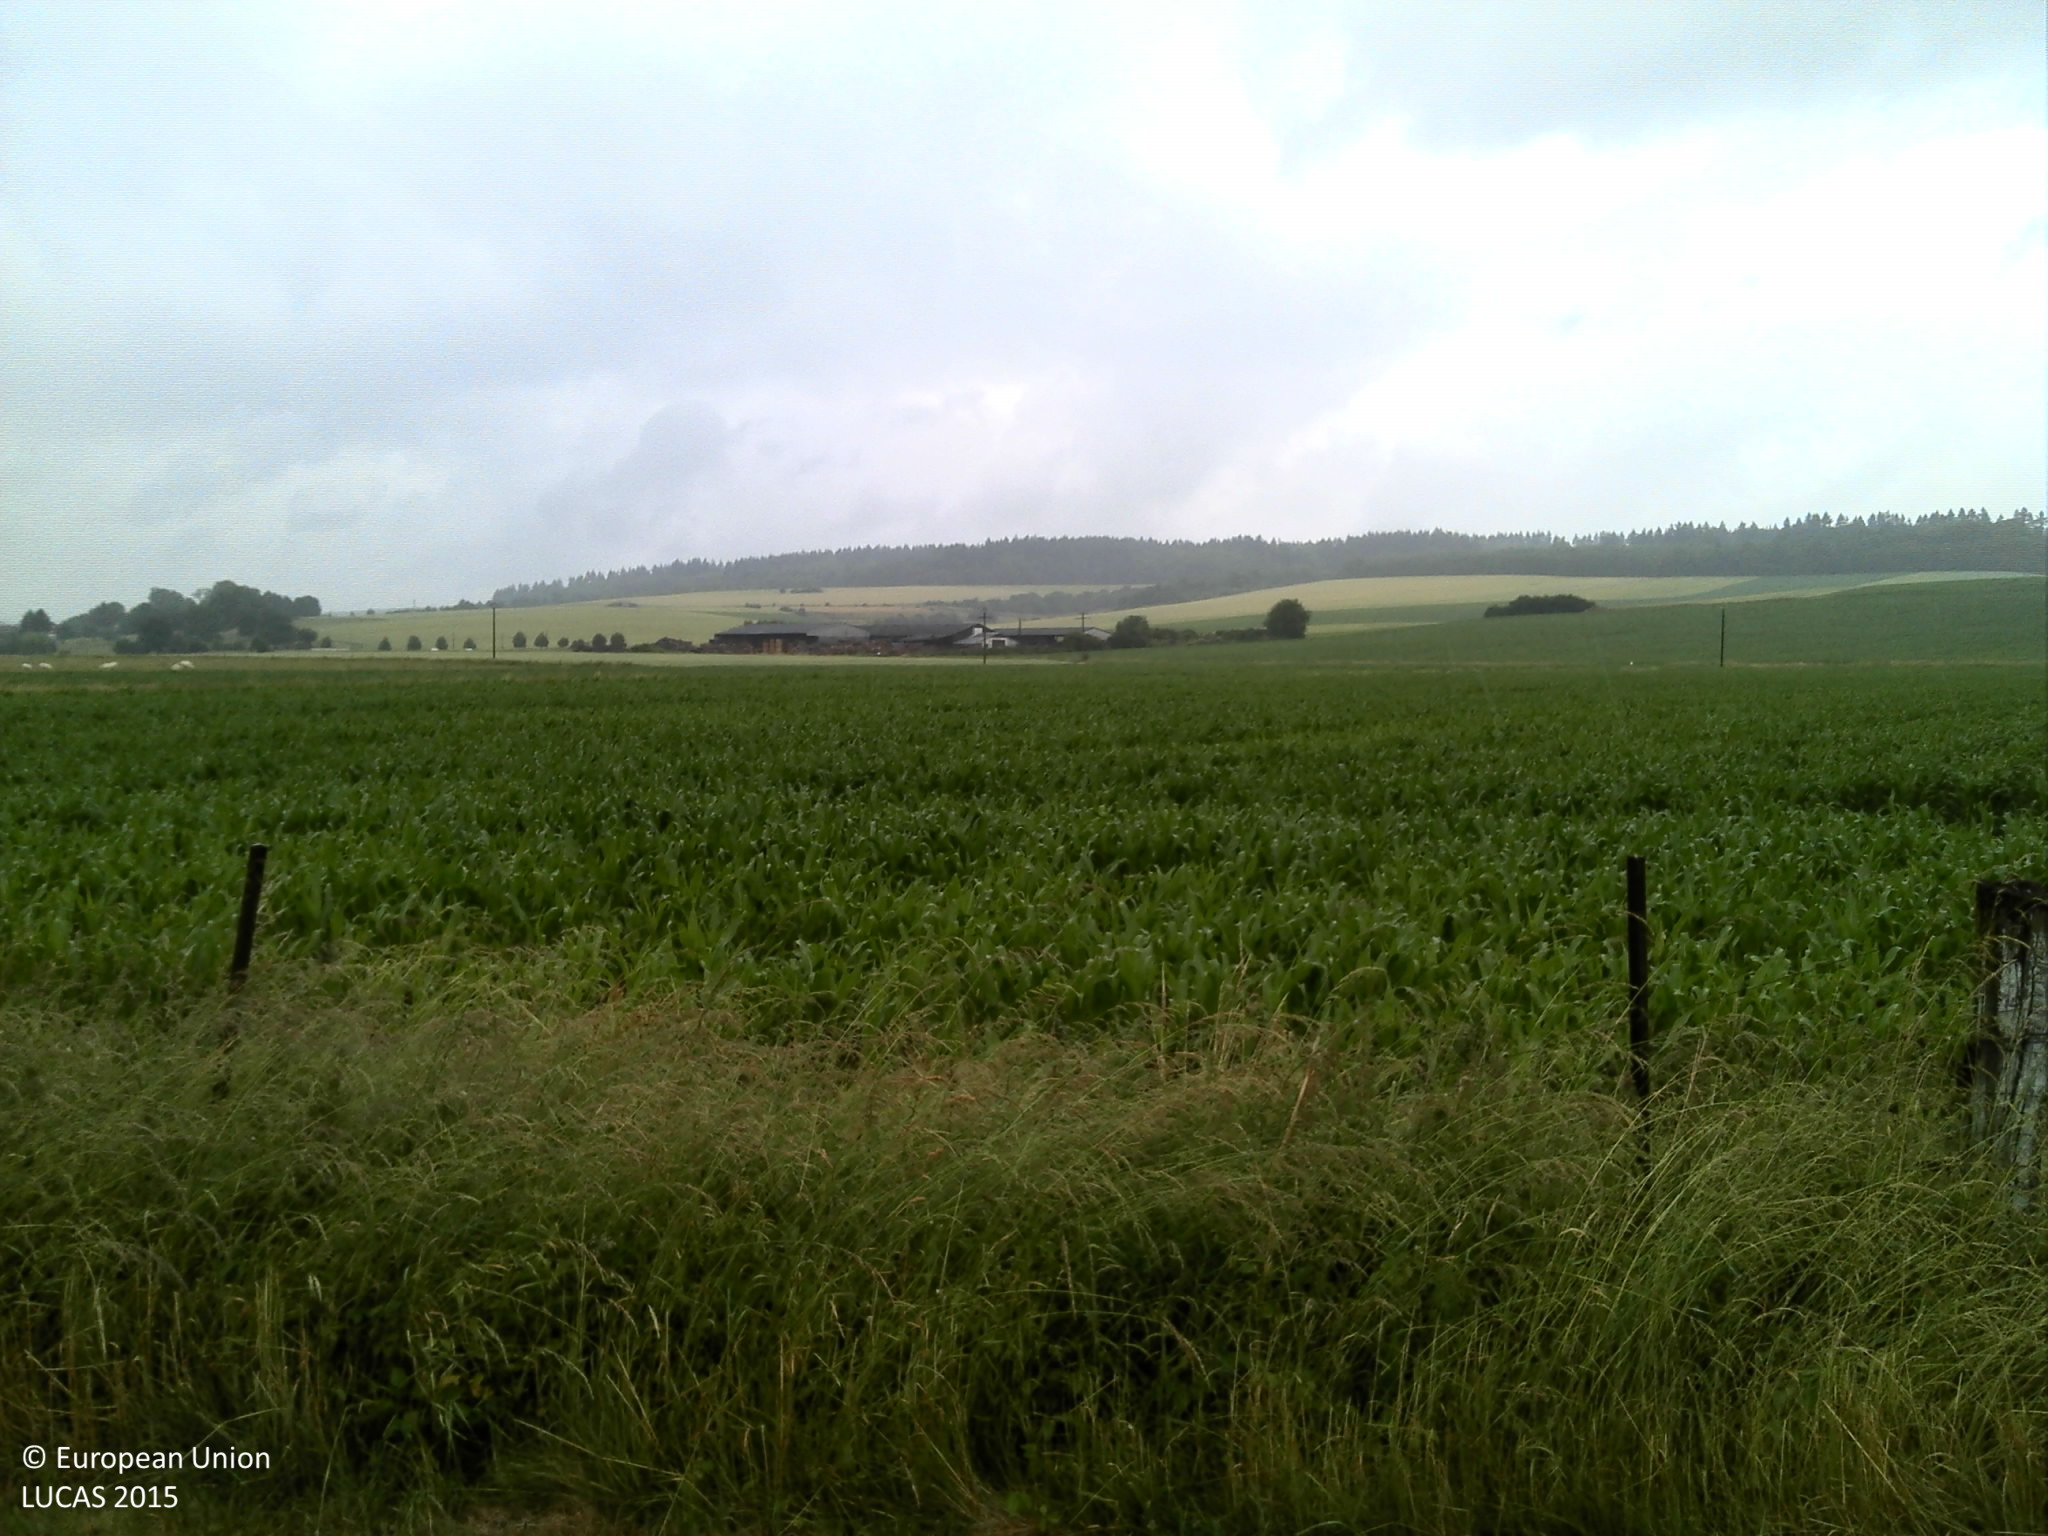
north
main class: Grassland
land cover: Grassland without tree/shrub cover
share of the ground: > 75 %
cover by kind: herbaceous plants 100 %
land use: Amenities, museums, leisure
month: June
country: FR
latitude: 49.5975
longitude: 4.8087
